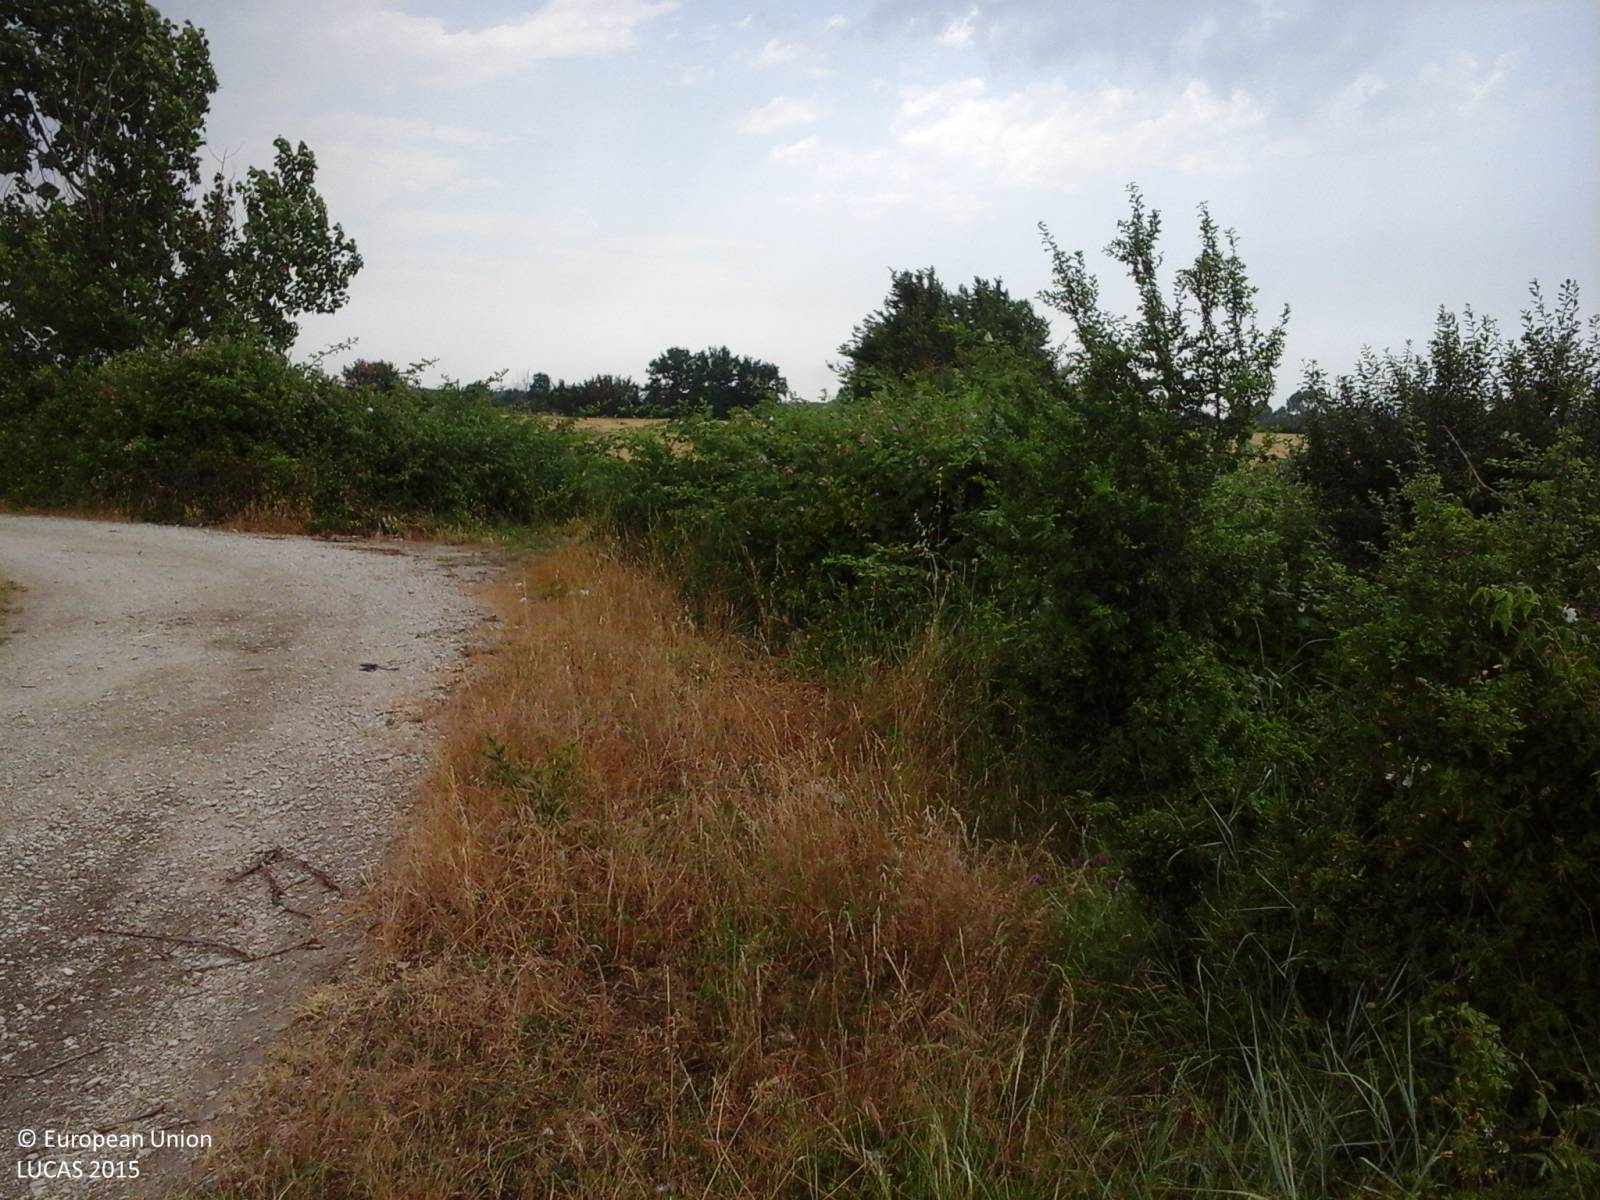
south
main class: Cropland
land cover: Barley
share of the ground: > 75 %
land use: Agriculture (excluding fallow land and kitchen gardens)
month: June
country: IT
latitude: 41.0838
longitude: 14.1852
